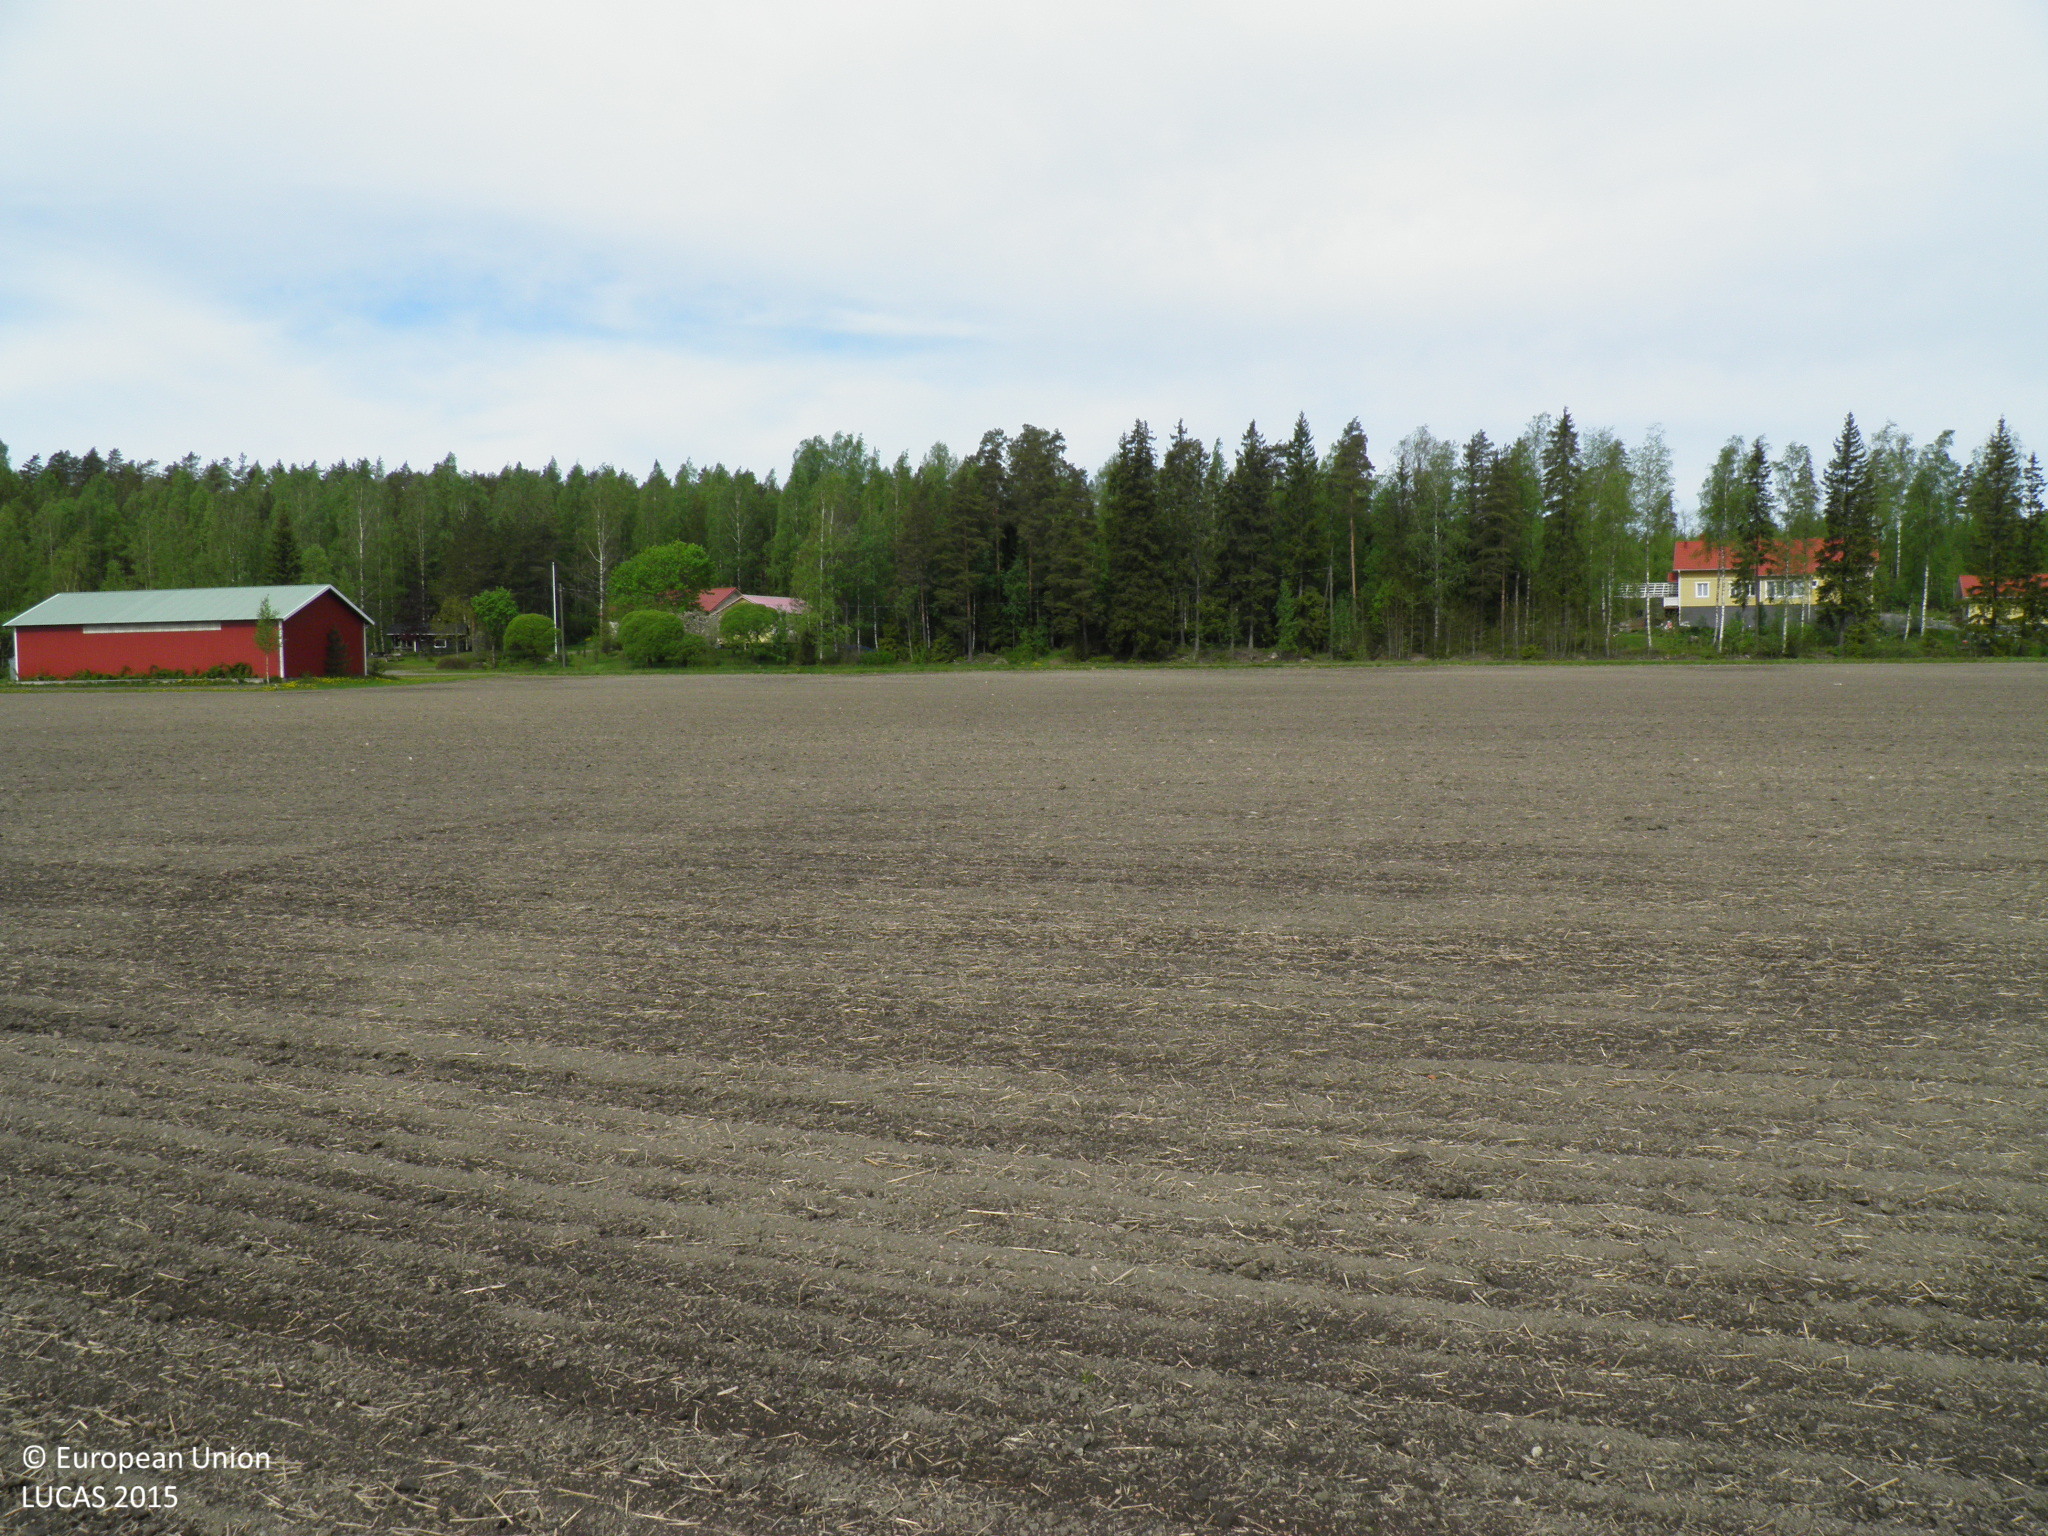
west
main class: Cropland
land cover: Common wheat
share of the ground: < 10 %
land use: Agriculture (excluding fallow land and kitchen gardens)
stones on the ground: < 10 %
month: June
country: FI
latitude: 60.5384
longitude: 22.6674
